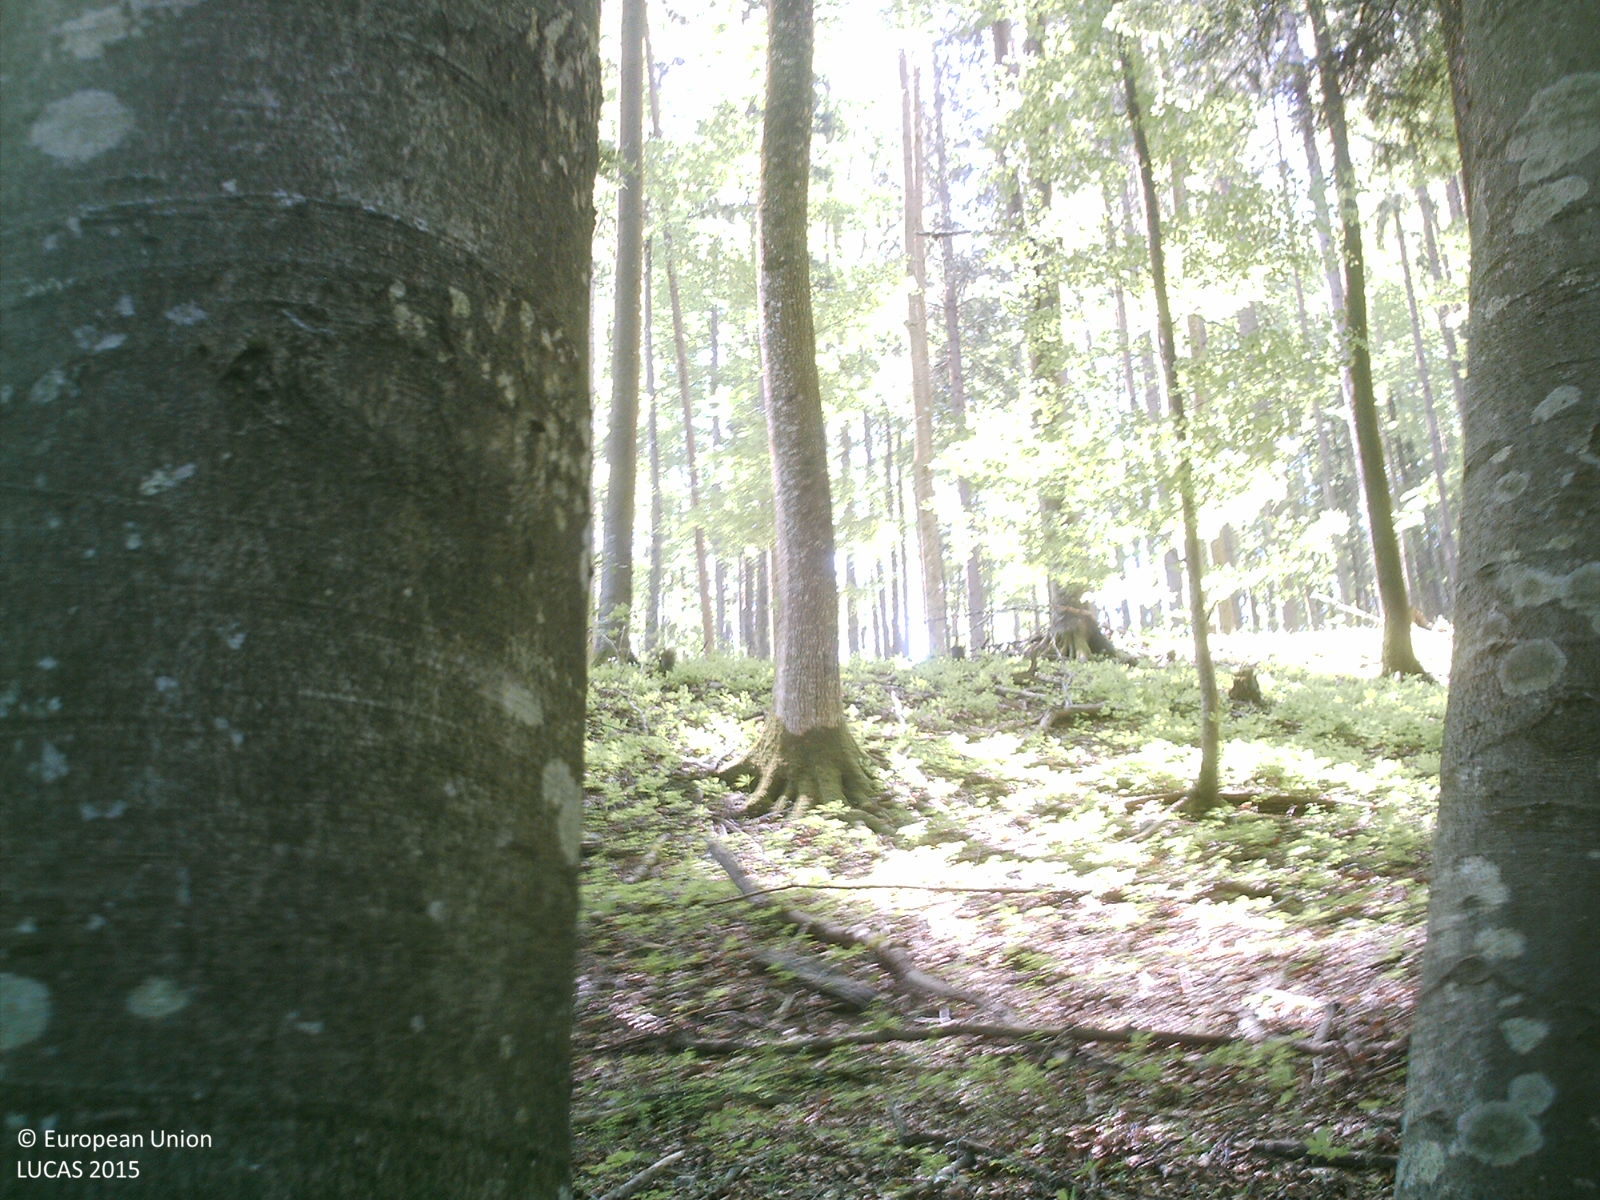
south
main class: Woodland
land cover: Broadleaved woodland
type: mountainous beech forest
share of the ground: > 75 %
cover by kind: broadleaved forest trees 90 %, shrubs 5 %, herbaceous plants 5 %
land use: Forestry
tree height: > 5 m
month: May
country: AT
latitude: 47.8579
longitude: 14.1295
